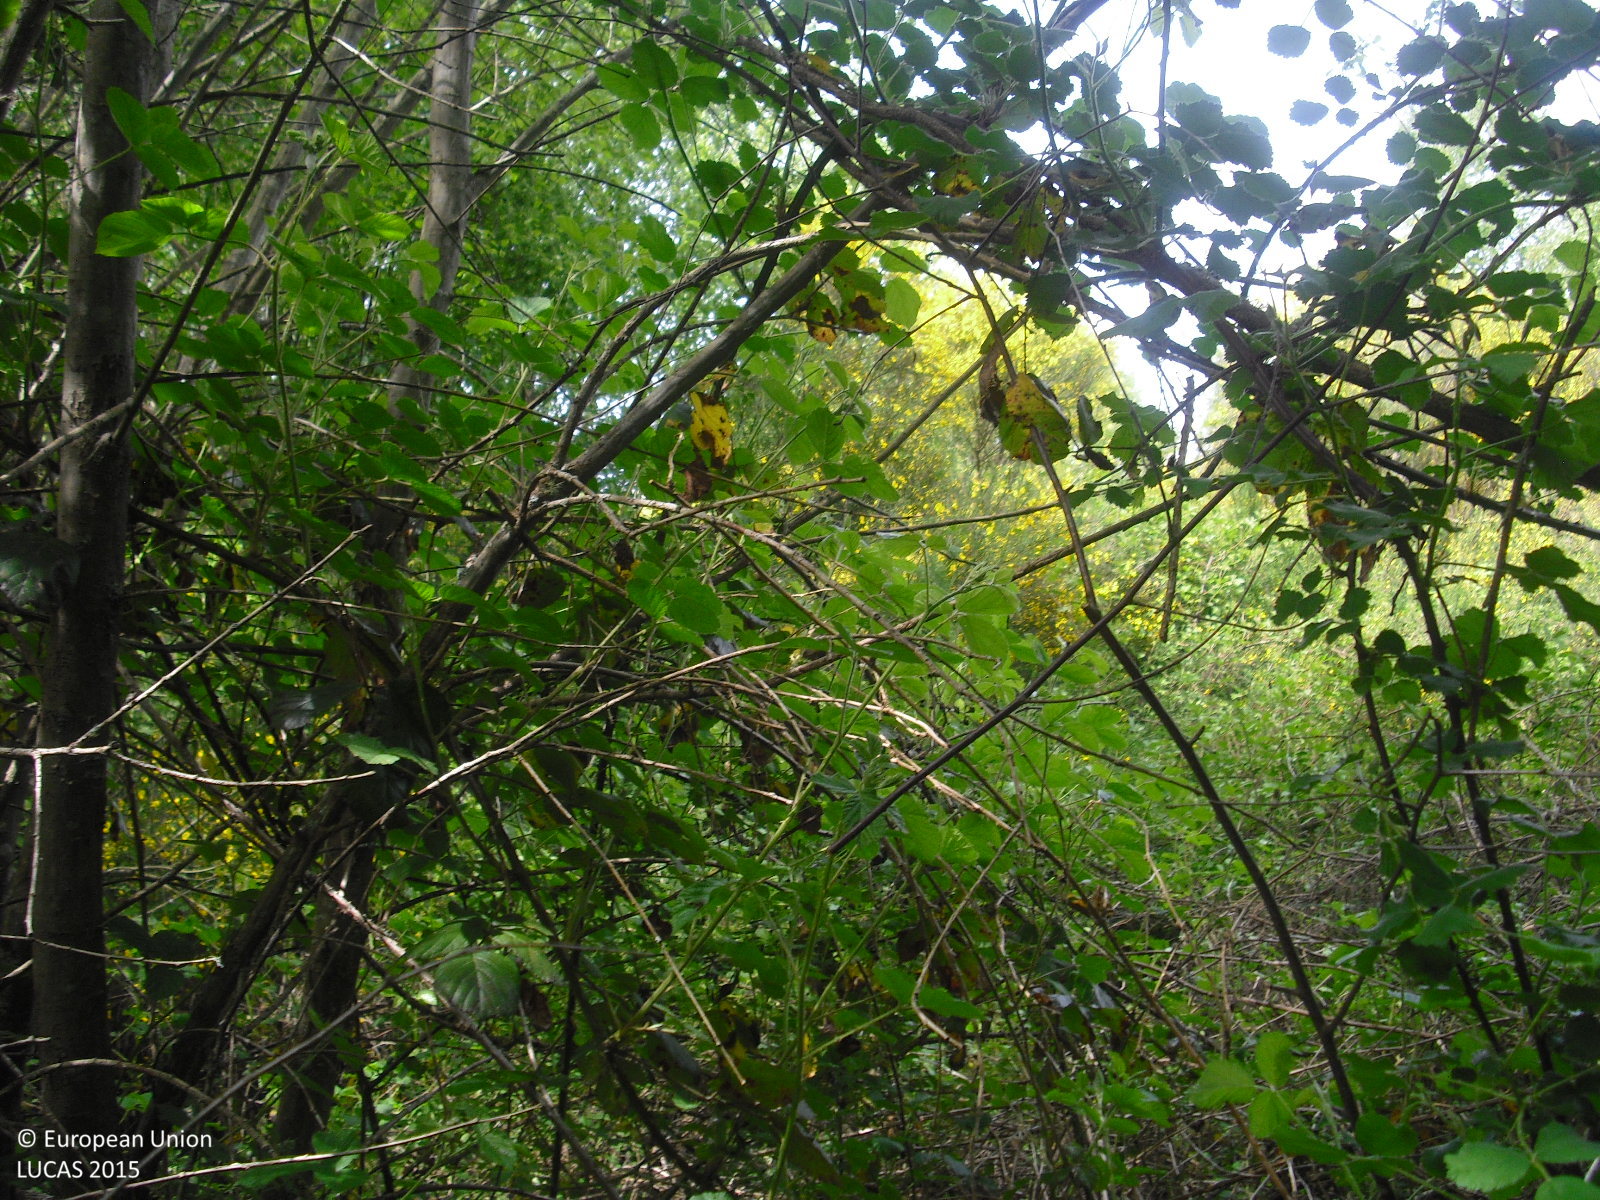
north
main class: Woodland
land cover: Broadleaved woodland
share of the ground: 50 - 75 %
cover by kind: broadleaved forest trees 60 %, shrubs 40 %
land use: Abandoned areas
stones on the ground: < 10 %
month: May
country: ES
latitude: 42.1420
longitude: -7.8485
